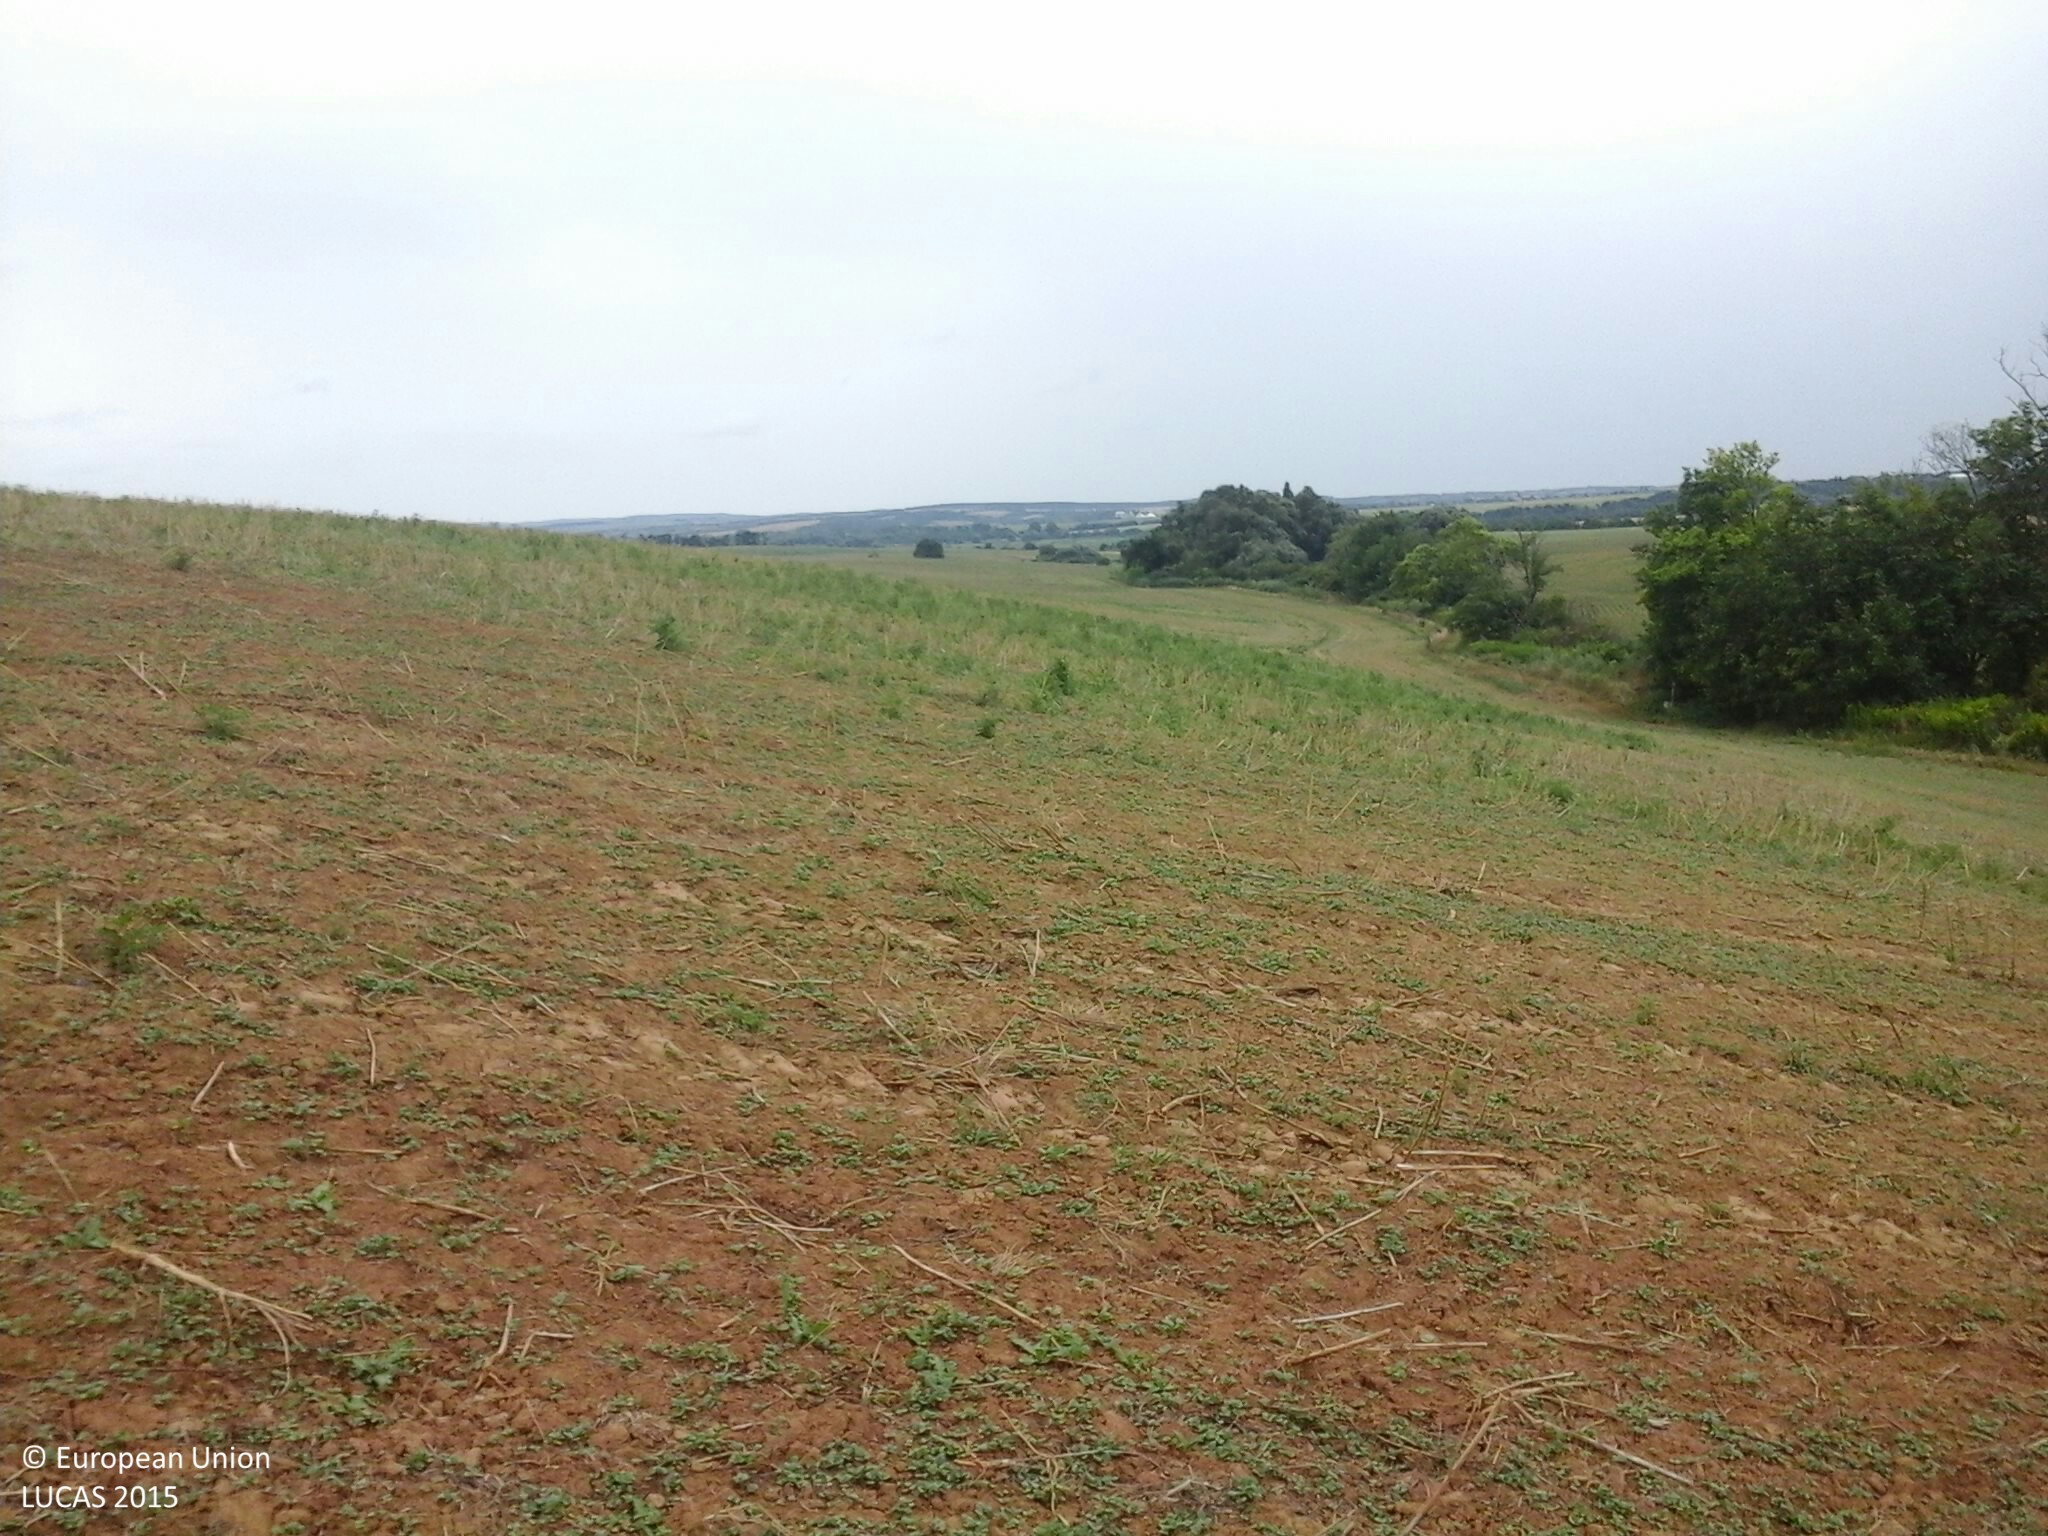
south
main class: Cropland
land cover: Rape and turnip rape
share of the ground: < 10 %
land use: Agriculture (excluding fallow land and kitchen gardens)
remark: Harvested field
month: July
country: HU
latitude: 46.7302
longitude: 17.8719
